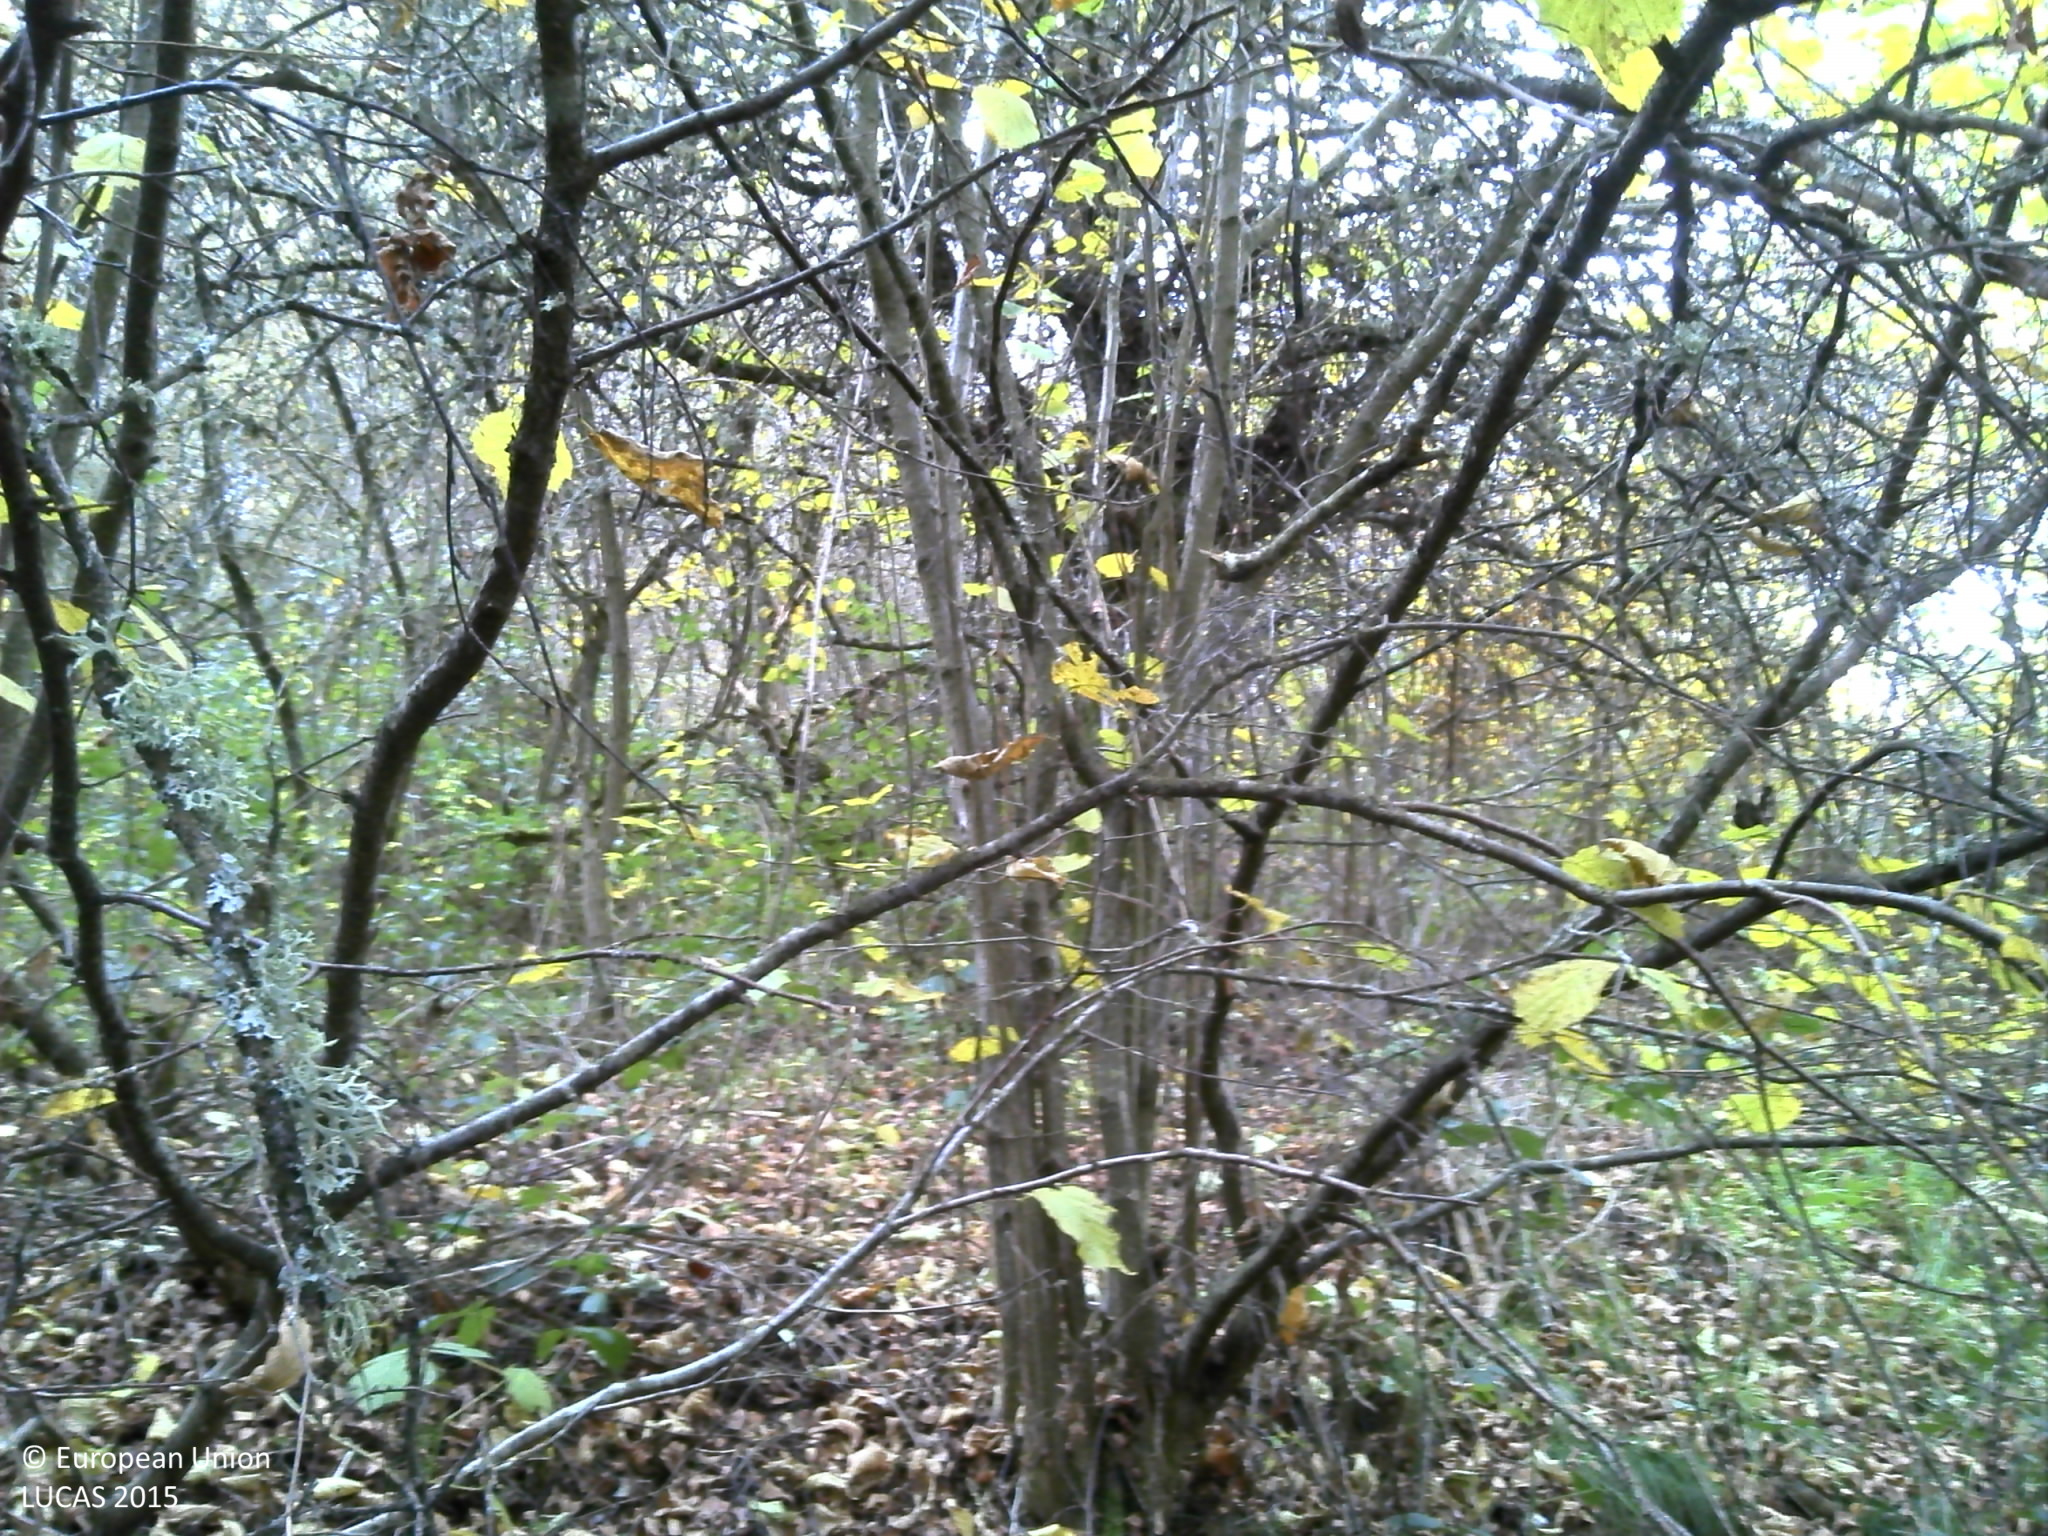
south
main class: Woodland
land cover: Broadleaved woodland
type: non-riverine alder, birch or aspen forest
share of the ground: > 75 %
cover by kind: broadleaved forest trees 70 %, shrubs 30 %
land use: Forestry
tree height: > 5 m
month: October
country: FR
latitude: 45.7853
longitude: 2.8342
